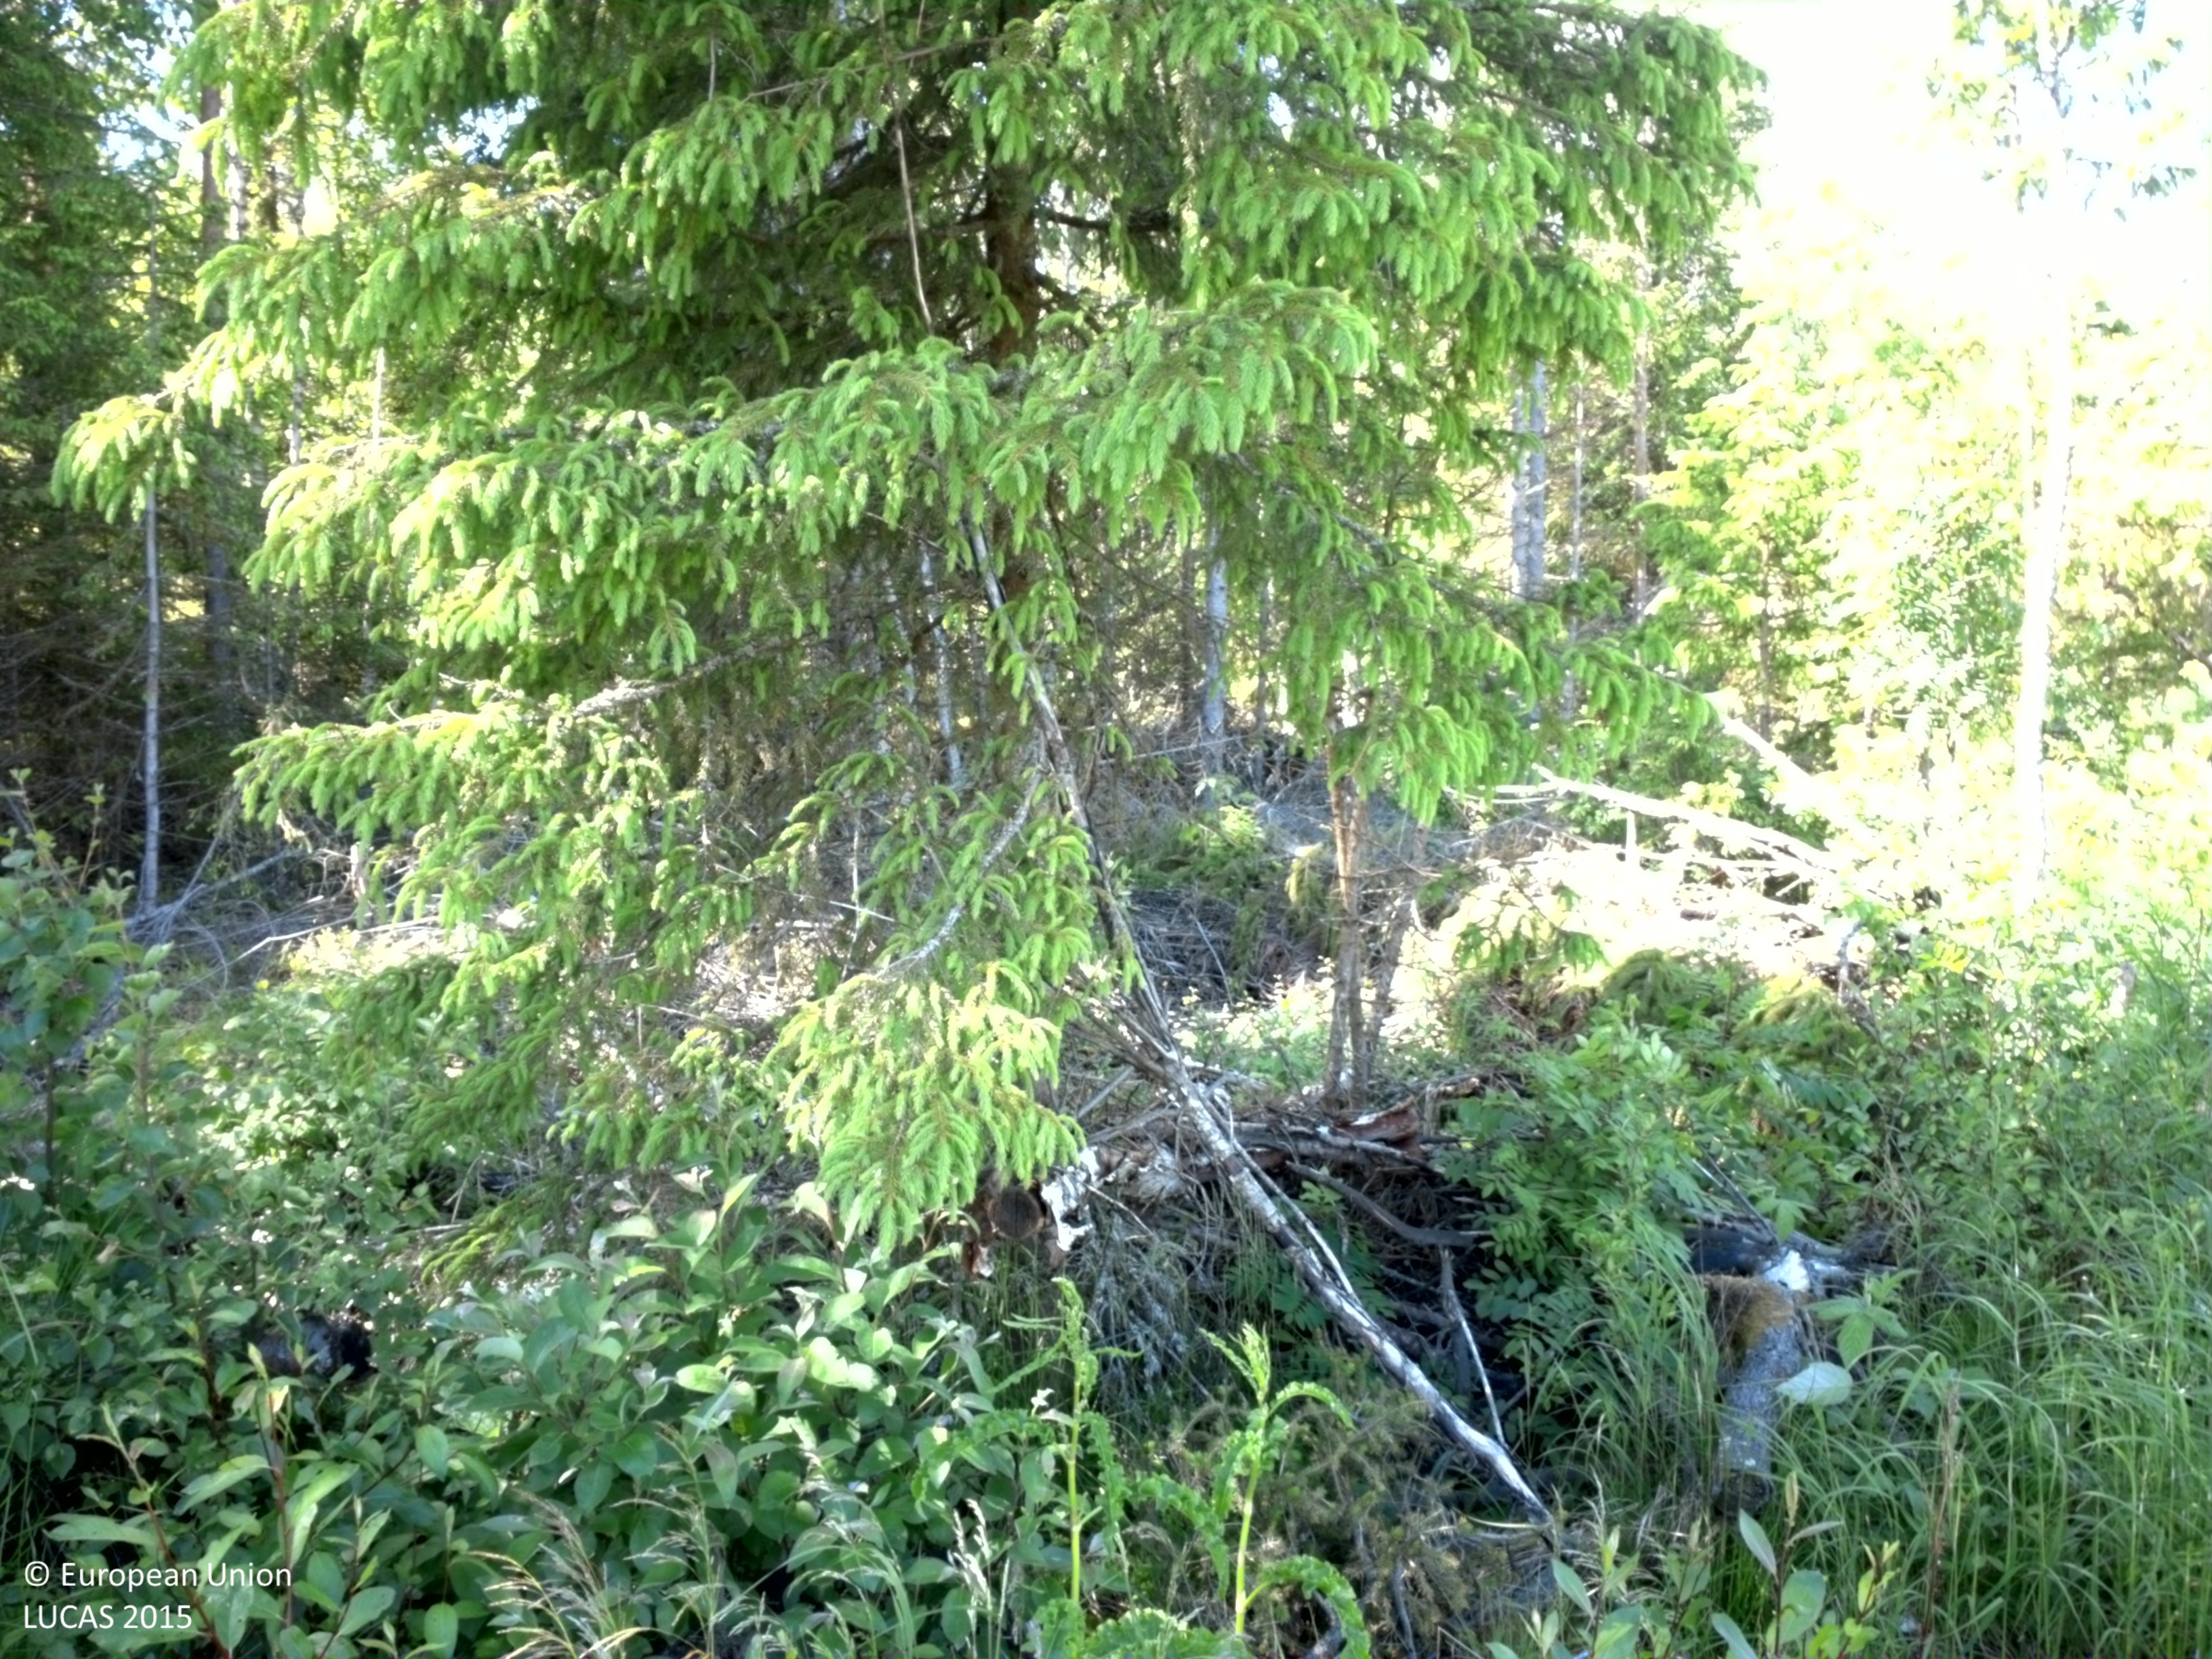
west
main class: Woodland
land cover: Spruce dominated mixed woodland
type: boreal forest
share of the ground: 50 - 75 %
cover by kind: coniferous forest trees 45 %, shrubs 30 %, broadleaved forest trees 15 %, herbaceous plants 10 %
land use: Forestry
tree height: > 5 m
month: June
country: SE
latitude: 64.2799
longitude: 20.8659
